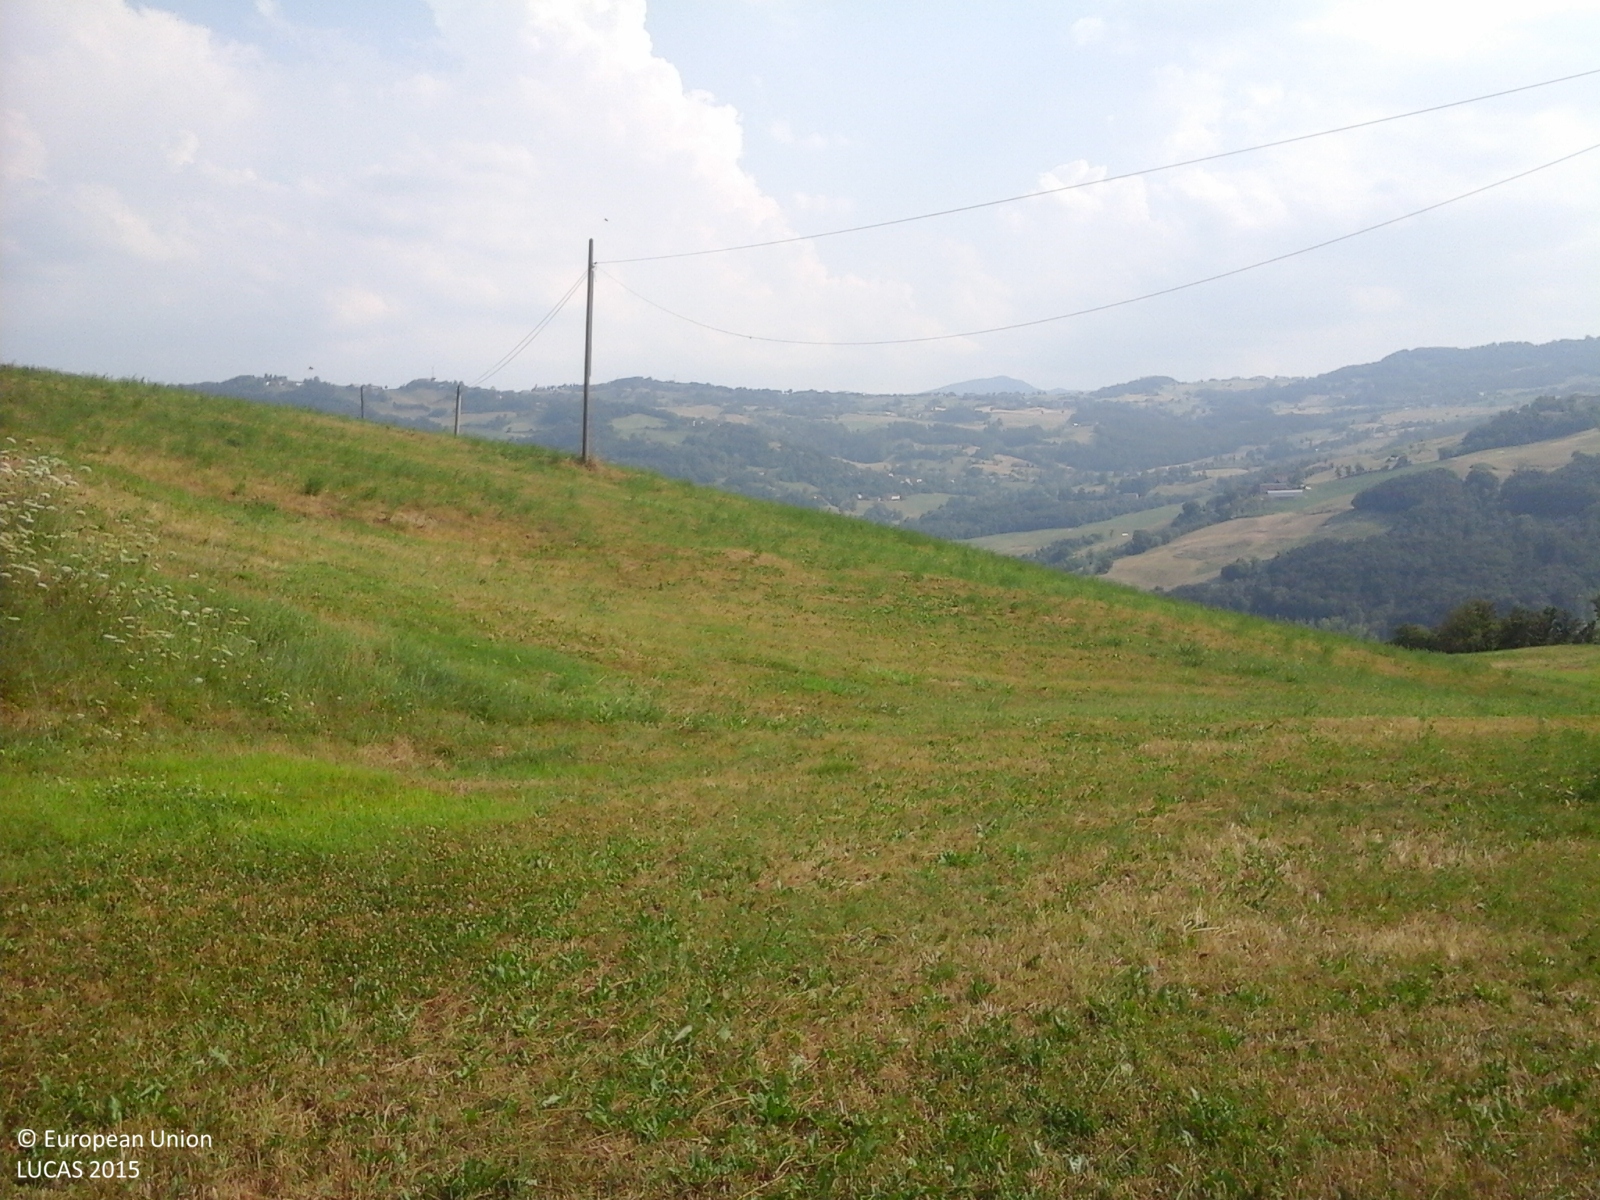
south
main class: Cropland
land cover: Lucerne
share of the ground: > 75 %
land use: Agriculture (excluding fallow land and kitchen gardens)
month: July
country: IT
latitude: 44.4210
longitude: 10.5890
